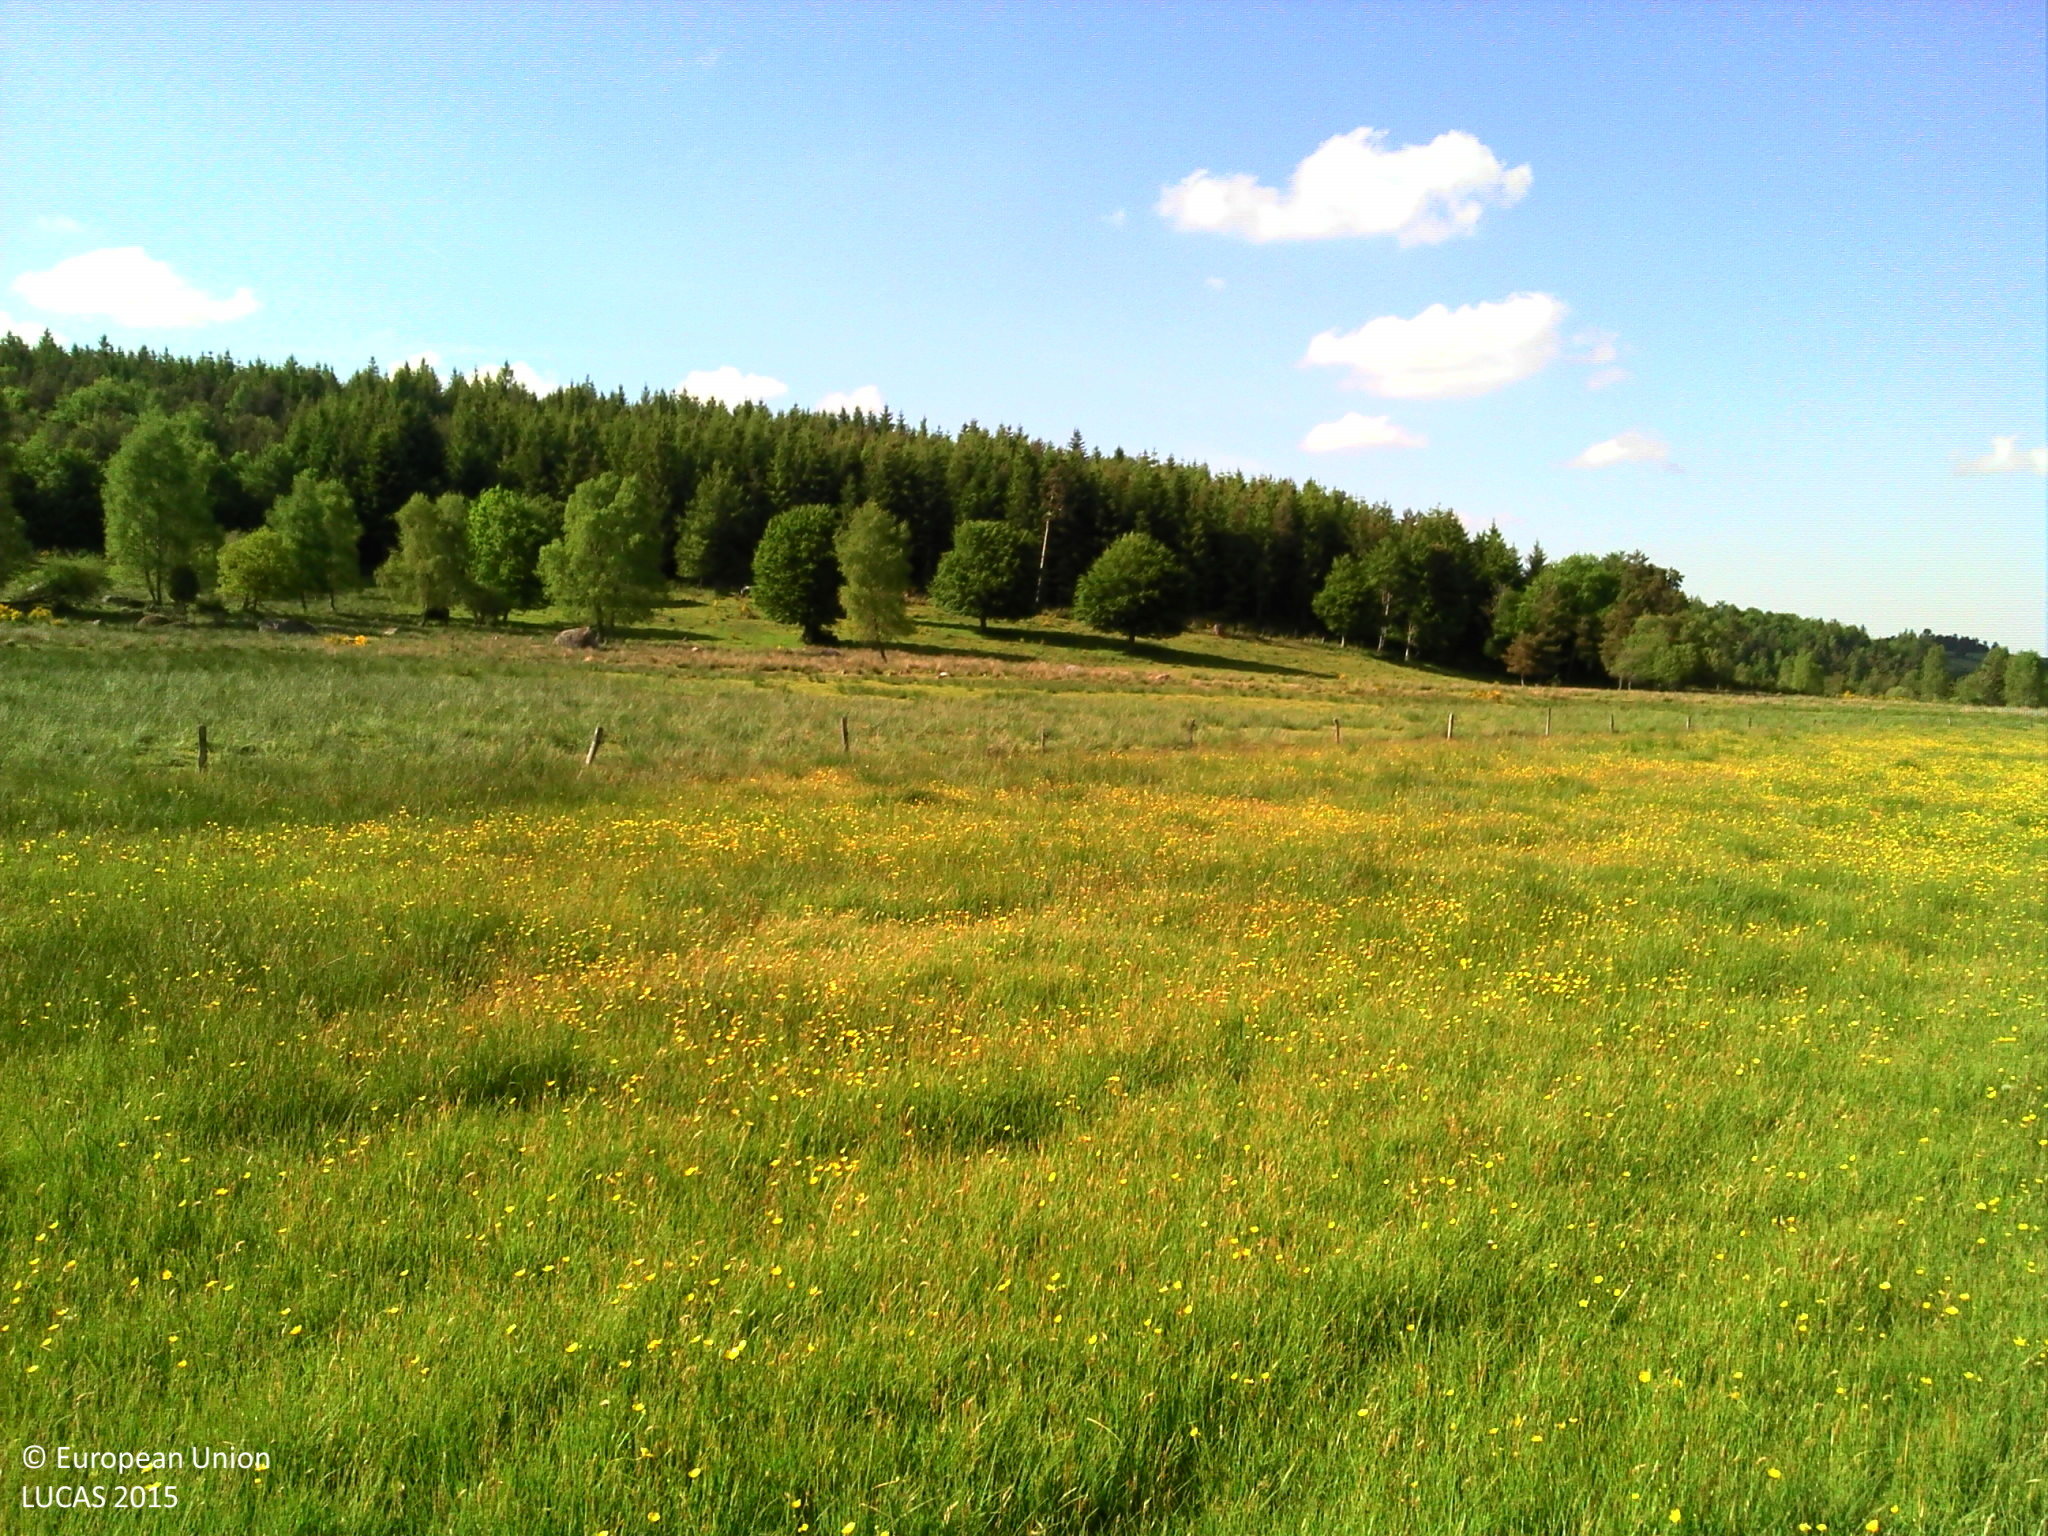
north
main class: Grassland
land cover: Grassland without tree/shrub cover
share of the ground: > 75 %
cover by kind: herbaceous plants 100 %
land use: Agriculture (excluding fallow land and kitchen gardens)
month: June
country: FR
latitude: 44.7794
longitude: 2.9384
